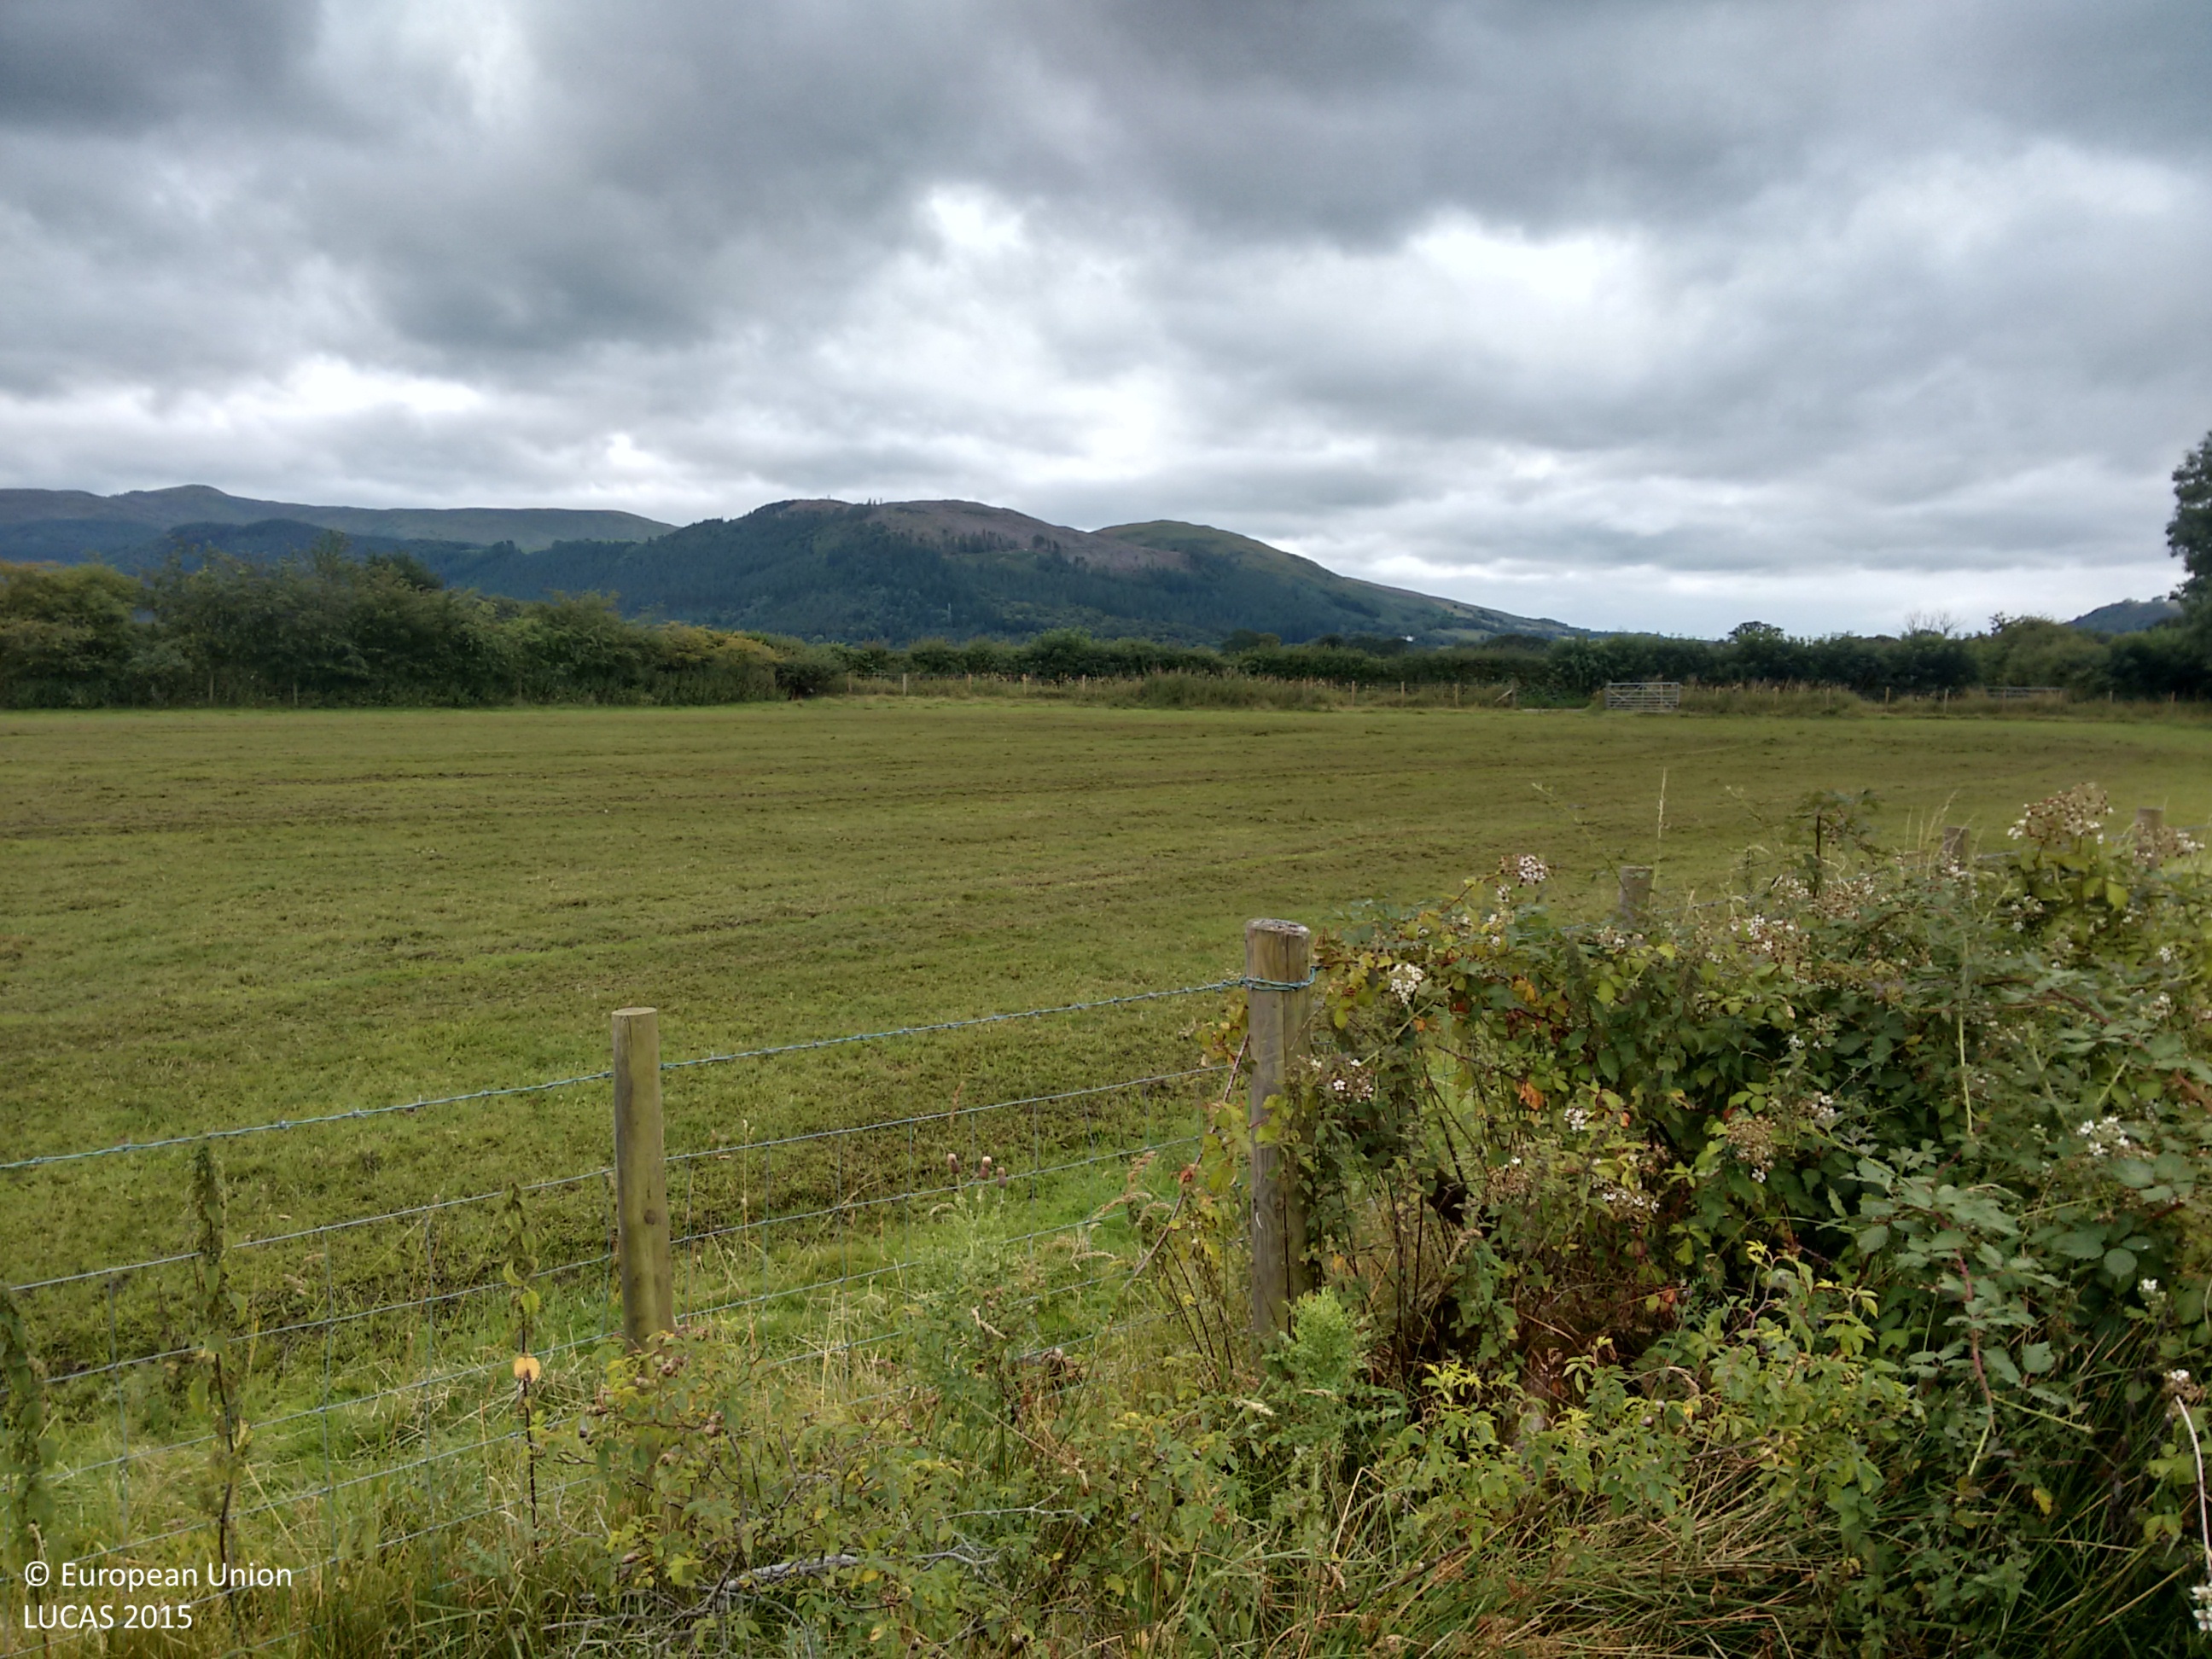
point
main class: Grassland
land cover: Grassland without tree/shrub cover
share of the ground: > 75 %
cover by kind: herbaceous plants 100 %
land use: Agriculture (excluding fallow land and kitchen gardens)
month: August
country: GB
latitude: 54.6796
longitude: -3.2125
